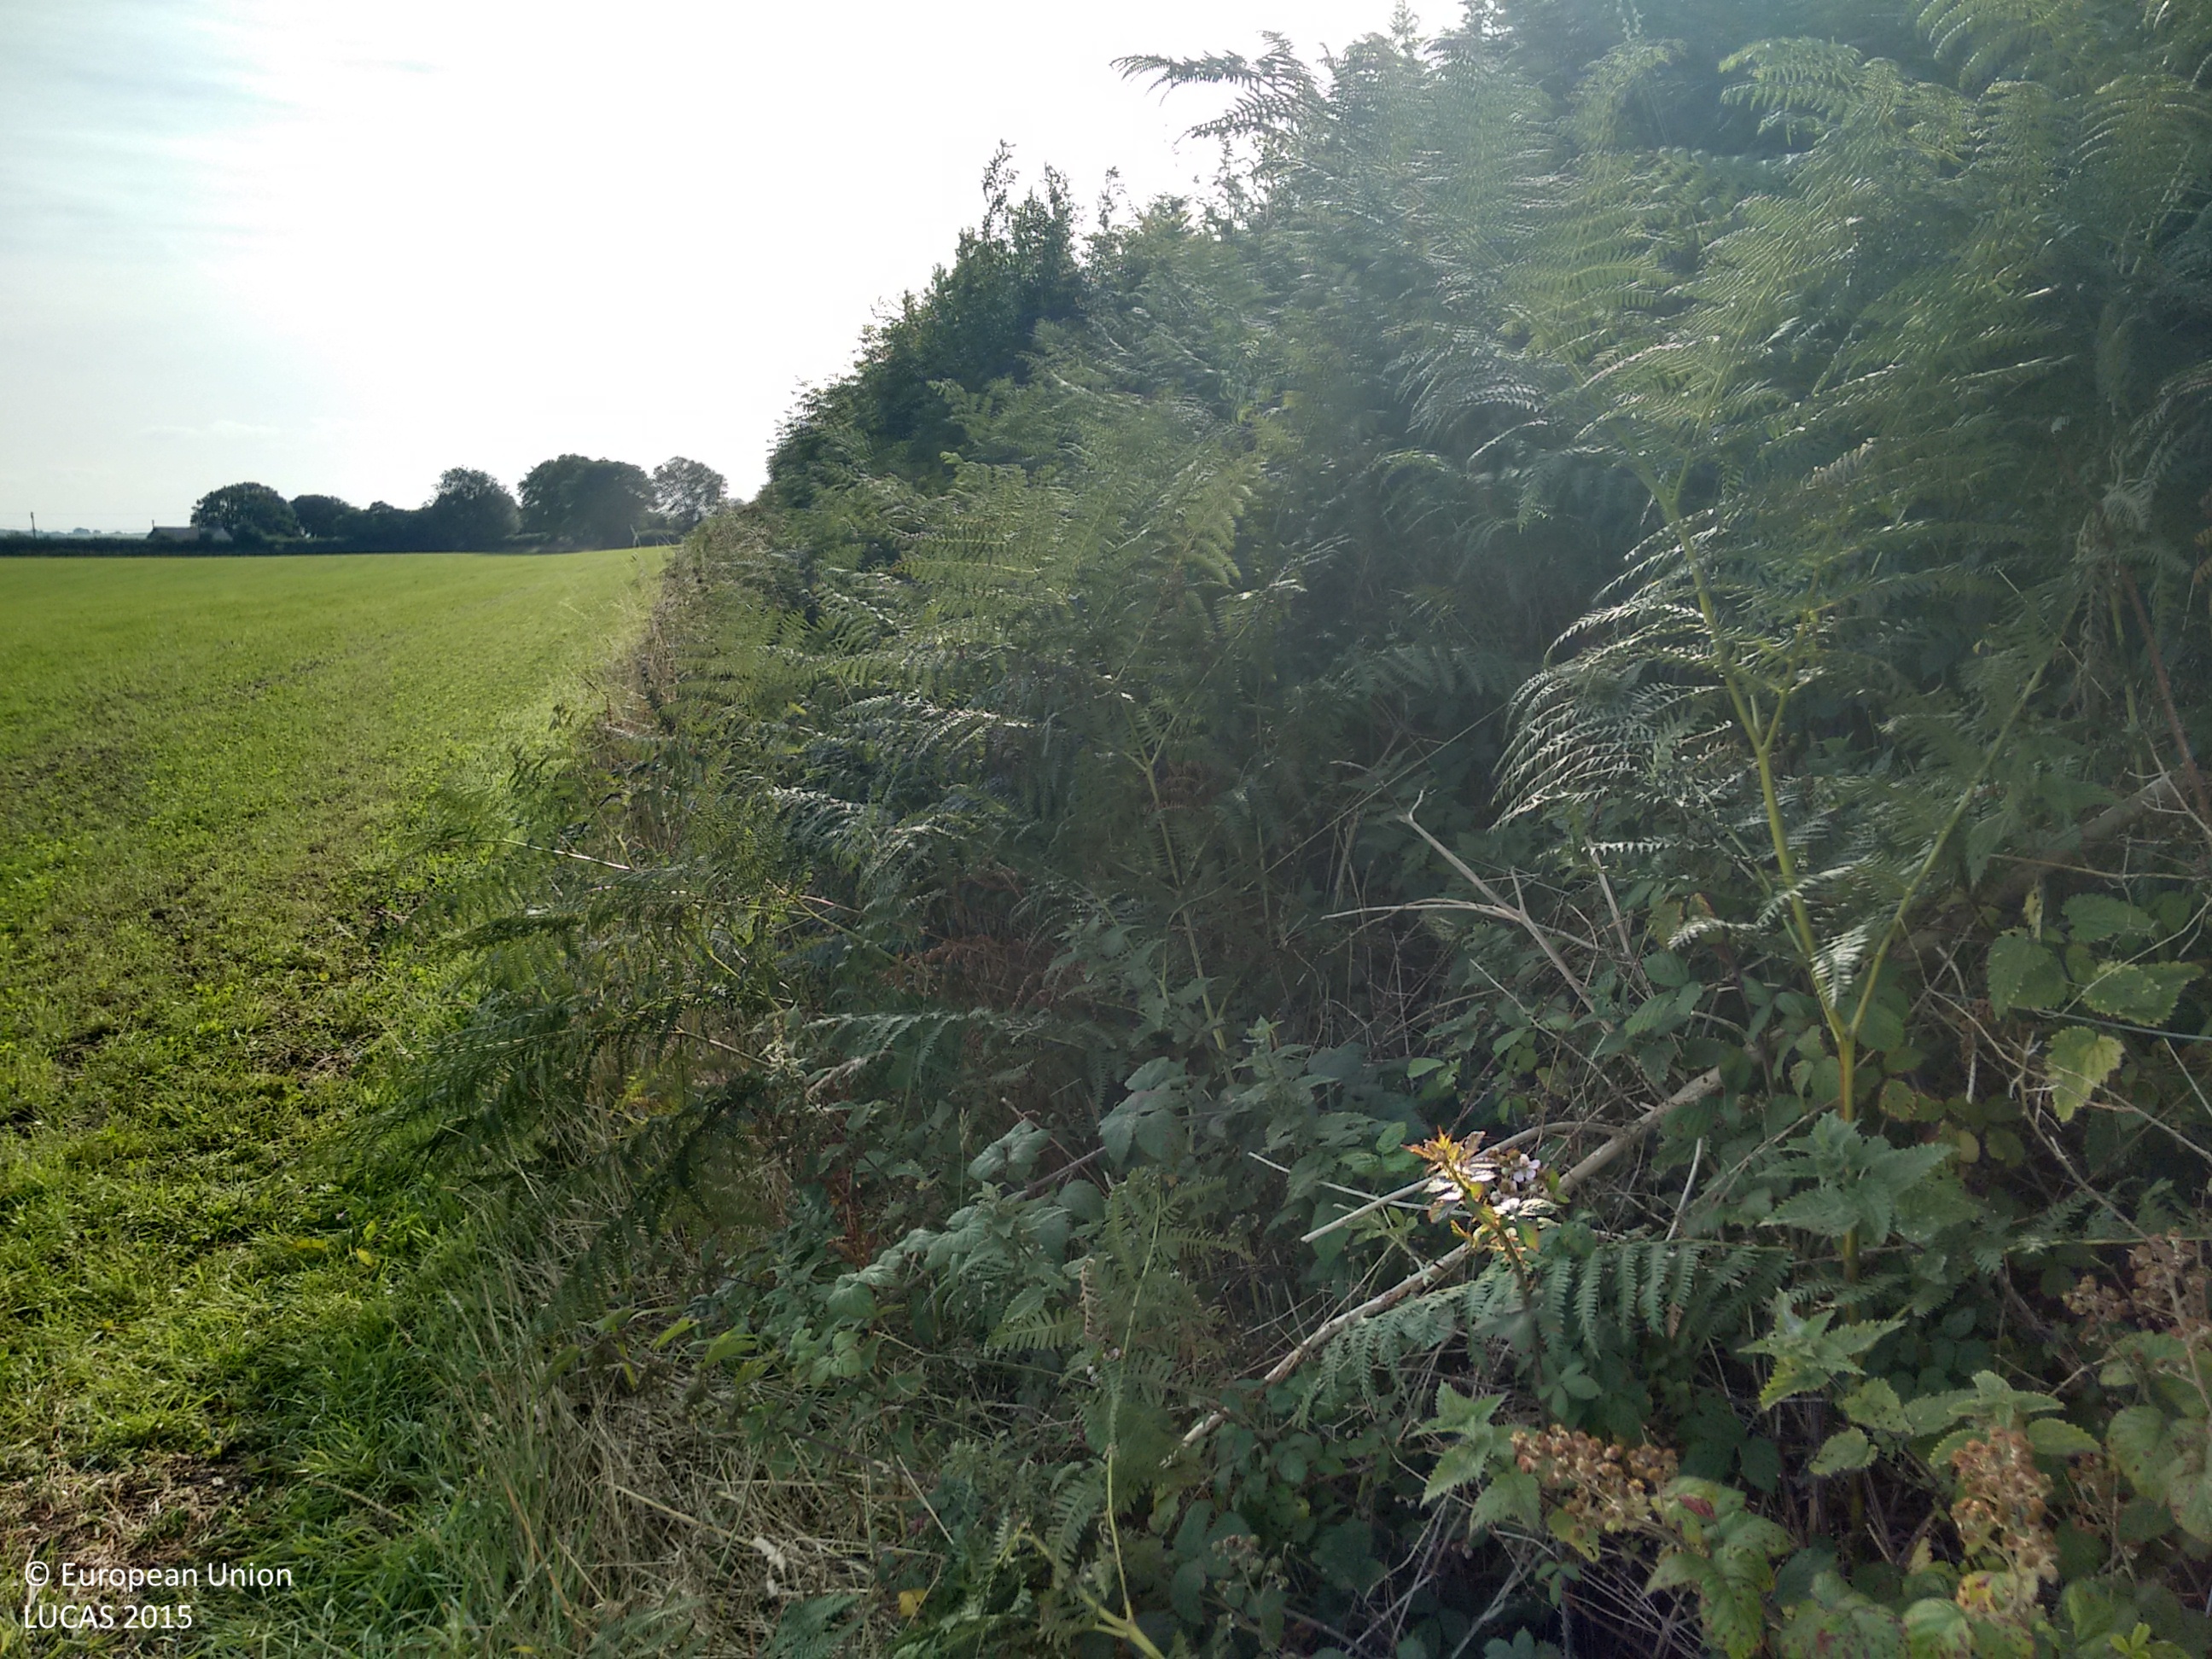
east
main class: Grassland
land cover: Grassland without tree/shrub cover
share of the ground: > 75 %
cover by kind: herbaceous plants 100 %
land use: Agriculture (excluding fallow land and kitchen gardens)
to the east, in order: Managed hedges; Shruby margins; Grassland without tree/shrub cover; Shruby margins; Managed hedges; Shruby margins; Grassland without tree/shrub cover; Shruby margins; Managed hedges; Fences; Shruby margins; Grassland without tree/shrub cover
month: August
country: GB
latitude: 50.4343
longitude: -4.3918
